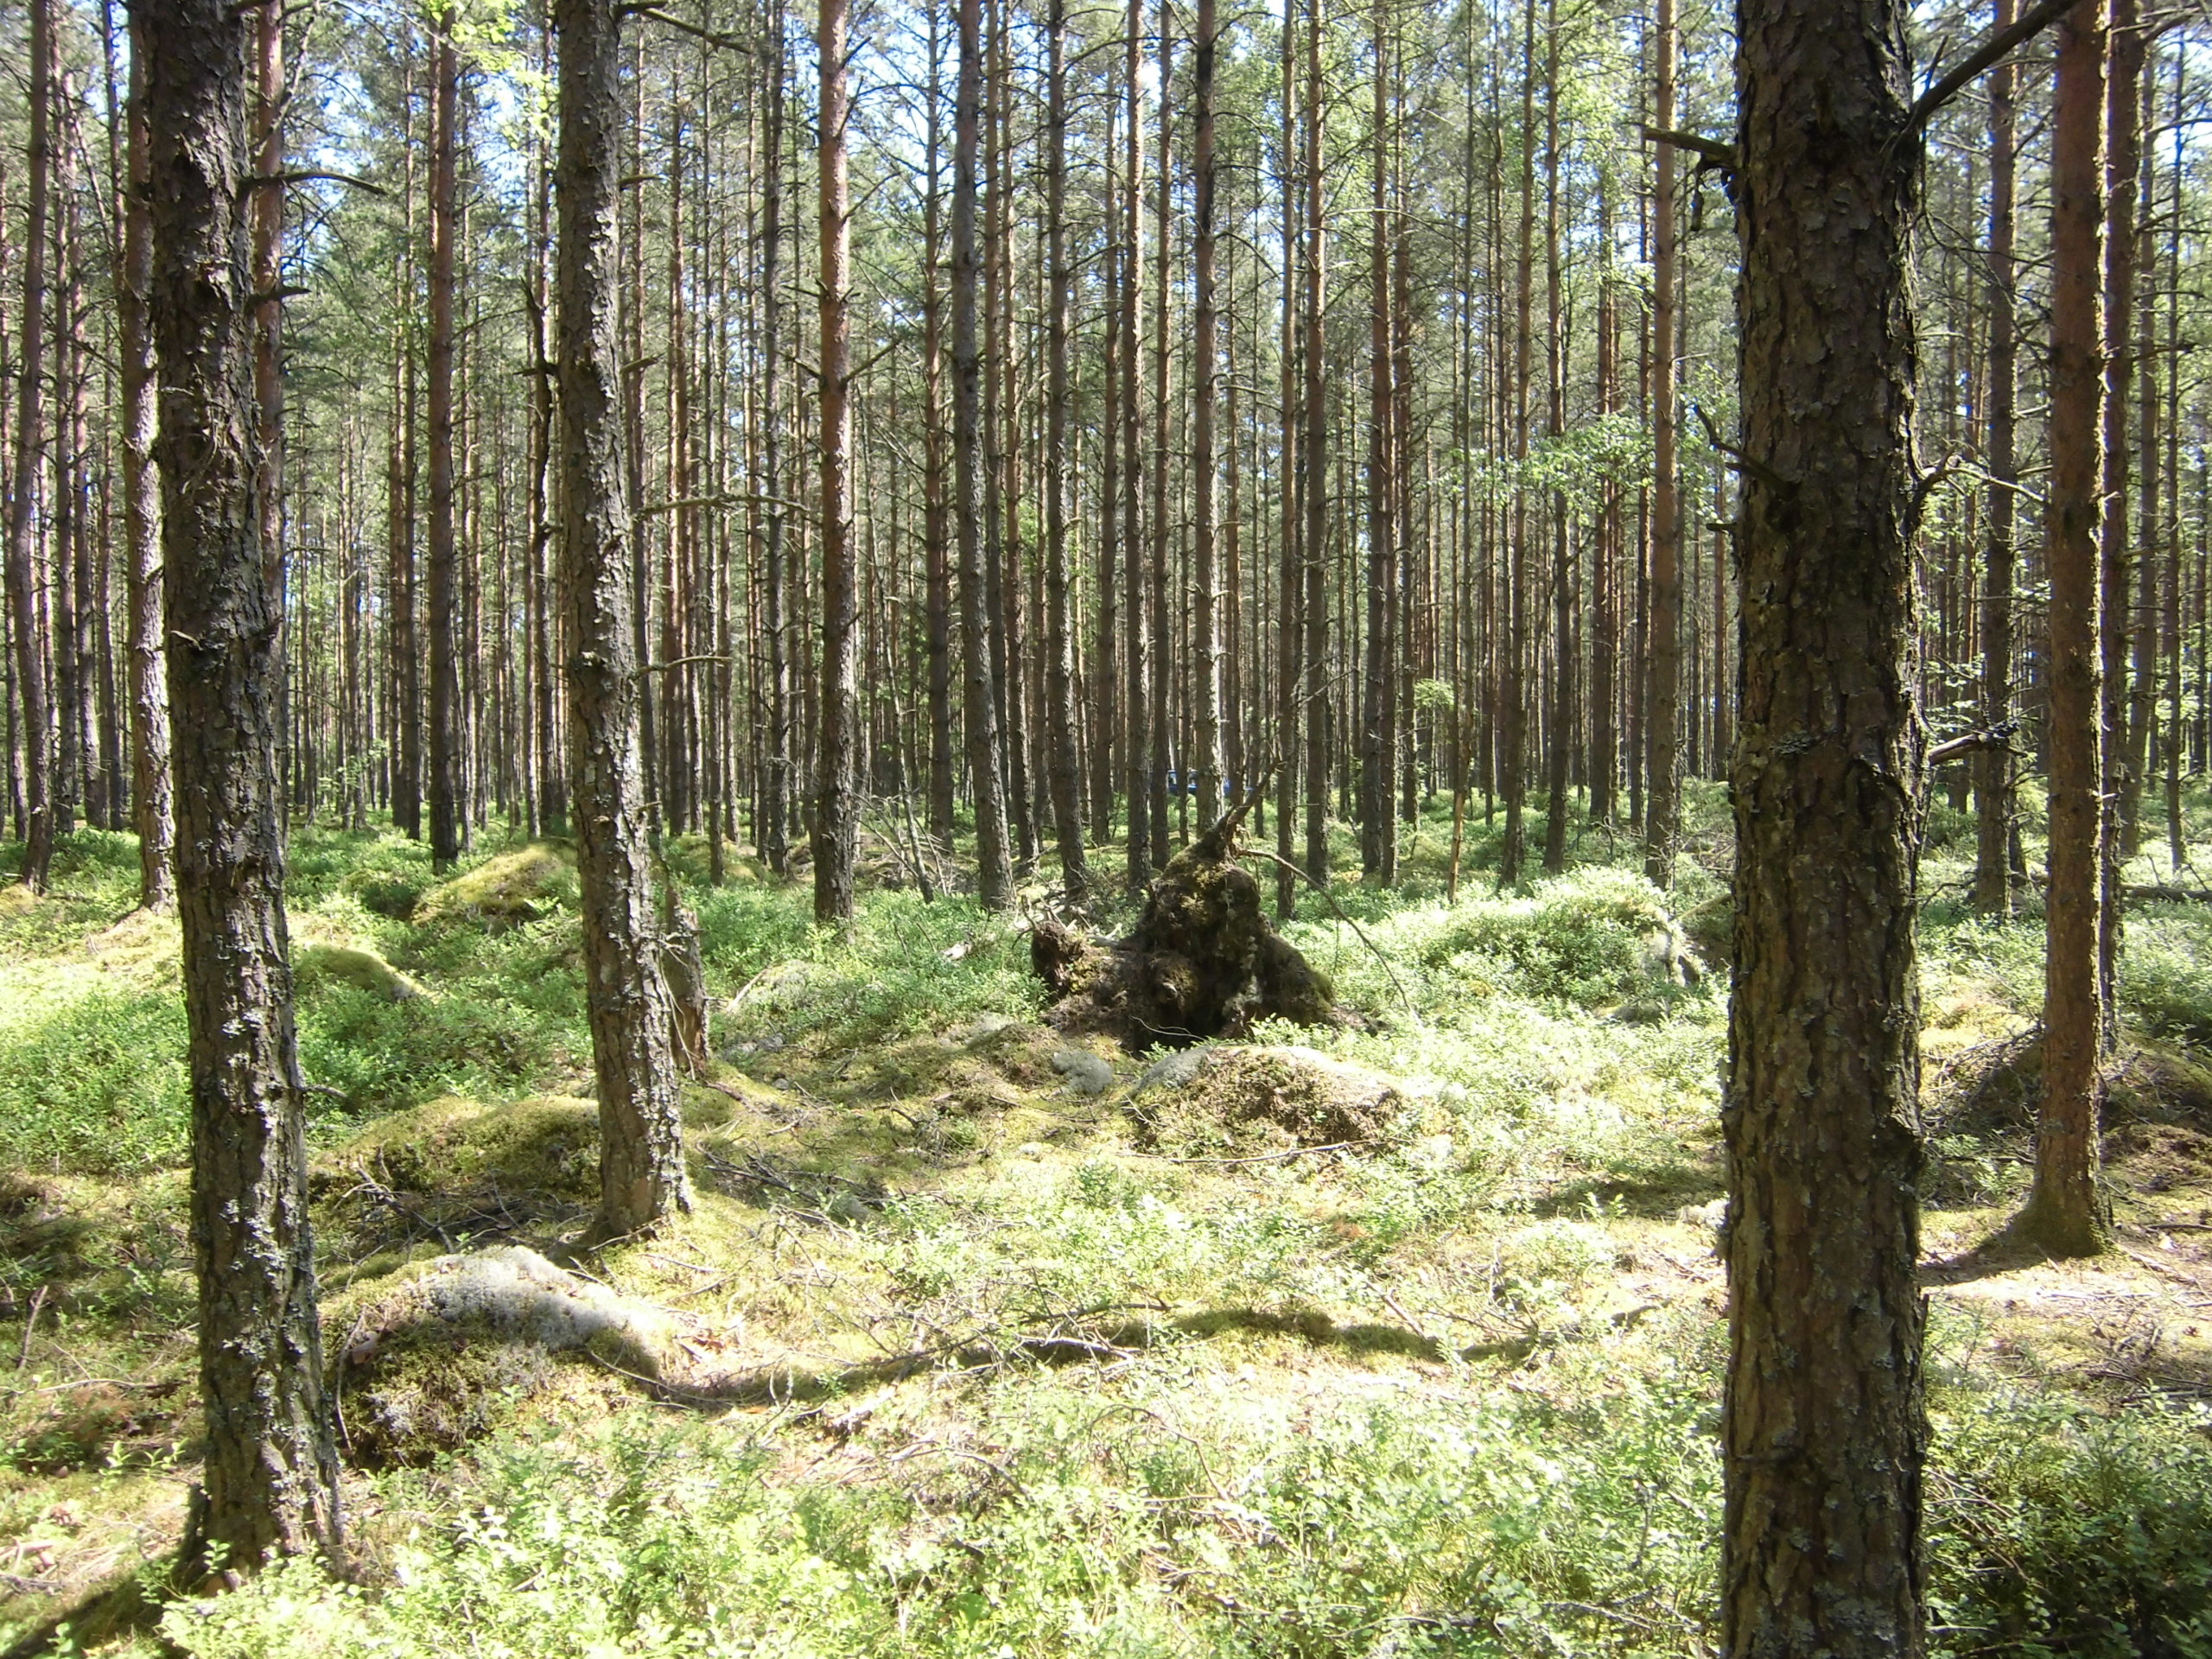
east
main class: Woodland
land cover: Pine dominated coniferous woodland
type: boreal forest
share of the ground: 50 - 75 %
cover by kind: coniferous forest trees 50 %, shrubs 25 %, herbaceous plants 25 %
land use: Forestry
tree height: > 5 m
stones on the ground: > 50 %
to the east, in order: Pine dominated coniferous woodland; Paved roads, cycling and walking lanes; Pine dominated coniferous woodland
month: July
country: SE
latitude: 57.2674
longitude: 14.3239
